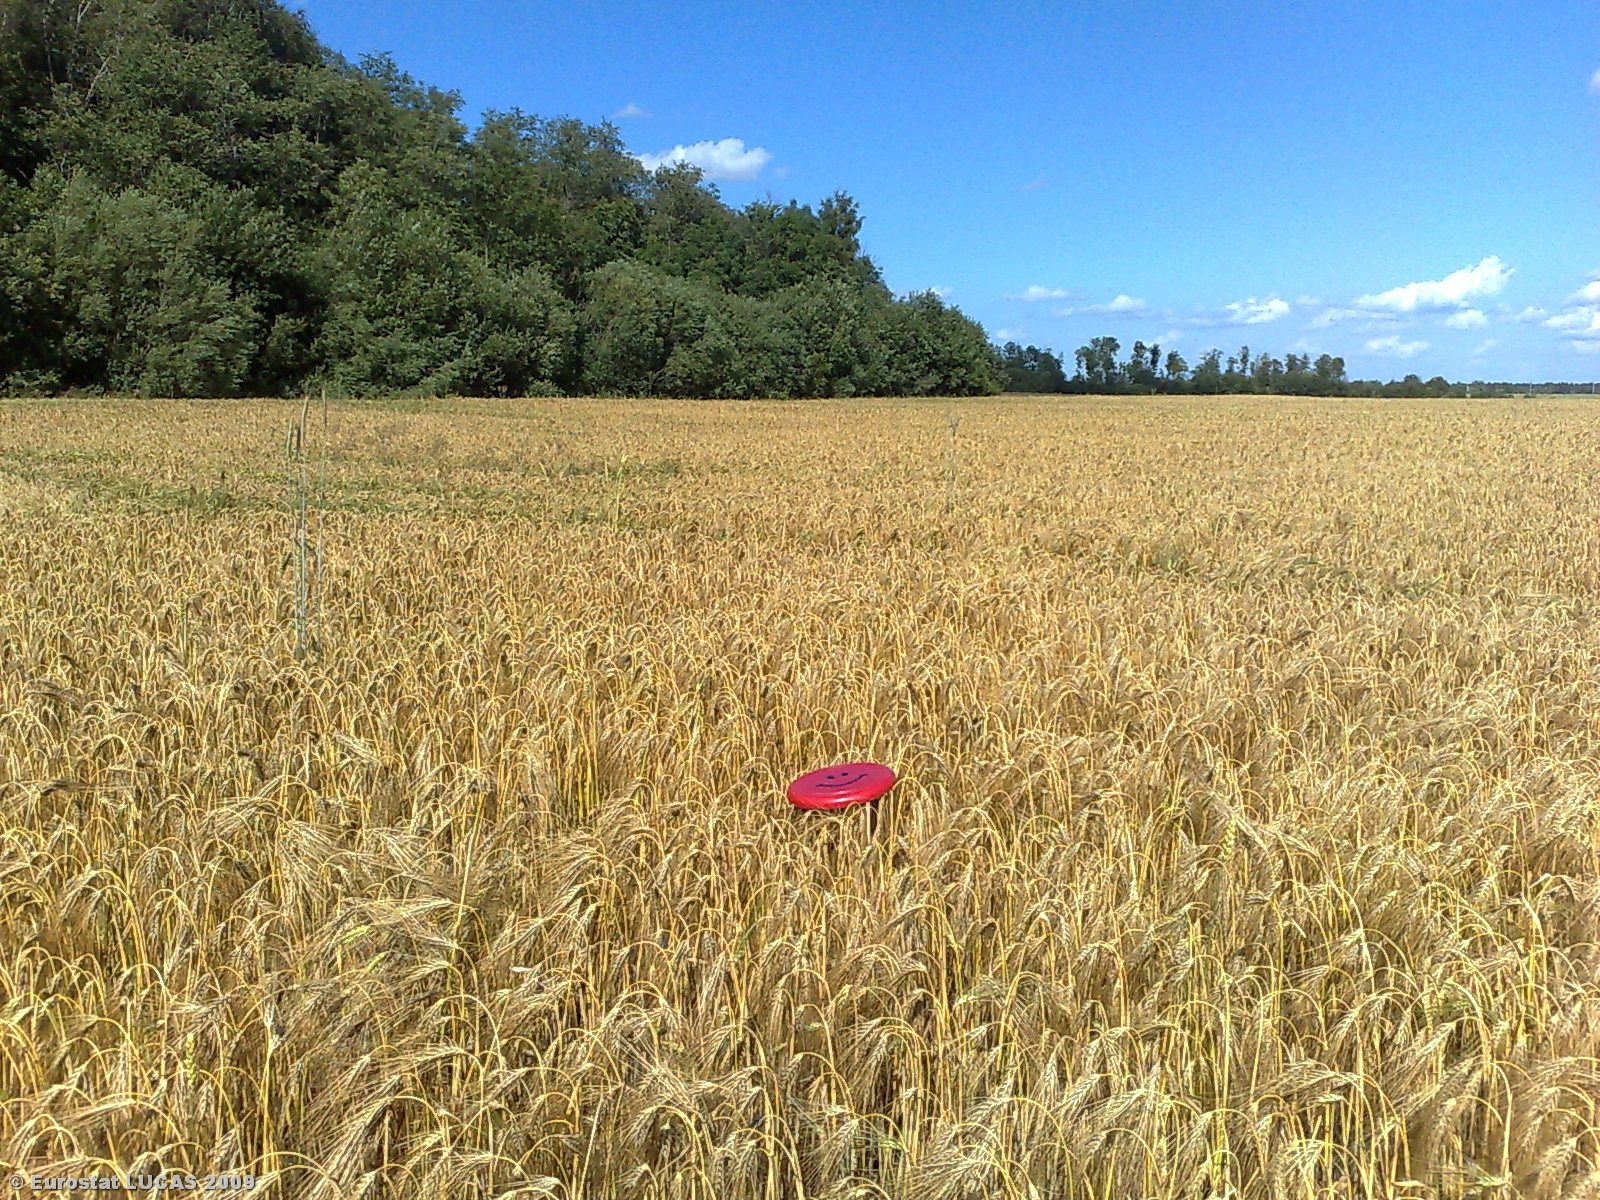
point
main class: Cropland
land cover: Triticale
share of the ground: > 75 %
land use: Agriculture (excluding fallow land and kitchen gardens)
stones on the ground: < 10 %
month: July
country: LT
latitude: 56.0942
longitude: 22.9416
